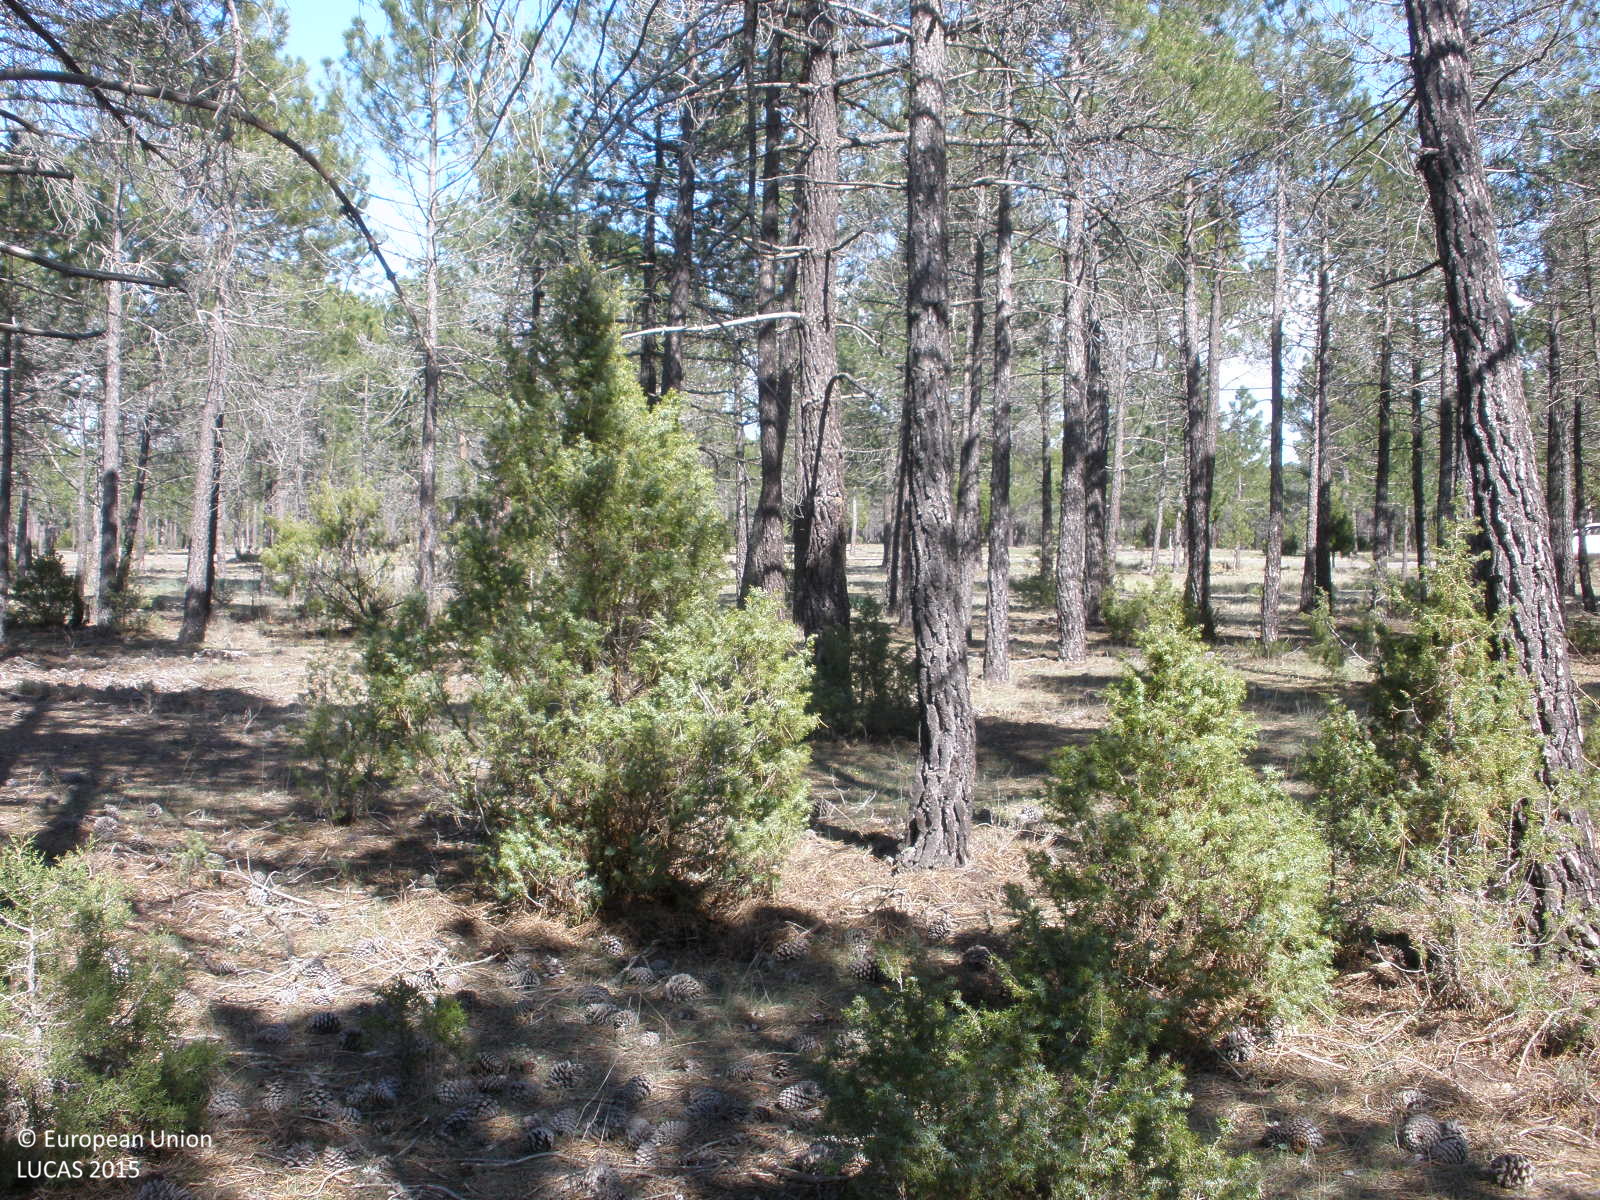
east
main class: Woodland
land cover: Pine dominated coniferous woodland
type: coniferous forest of the mediterranean region
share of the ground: 50 - 75 %
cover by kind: coniferous forest trees 60 %, shrubs 20 %, consolidated bare surface 20 %
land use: Semi-natural and natural areas not in use
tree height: > 5 m
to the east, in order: Pine dominated coniferous woodland; Paved roads, cycling and walking lanes; Pine dominated coniferous woodland; Tracks; Pine dominated coniferous woodland; Tracks; Pine dominated coniferous woodland
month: April
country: ES
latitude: 40.2912
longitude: -1.2688
